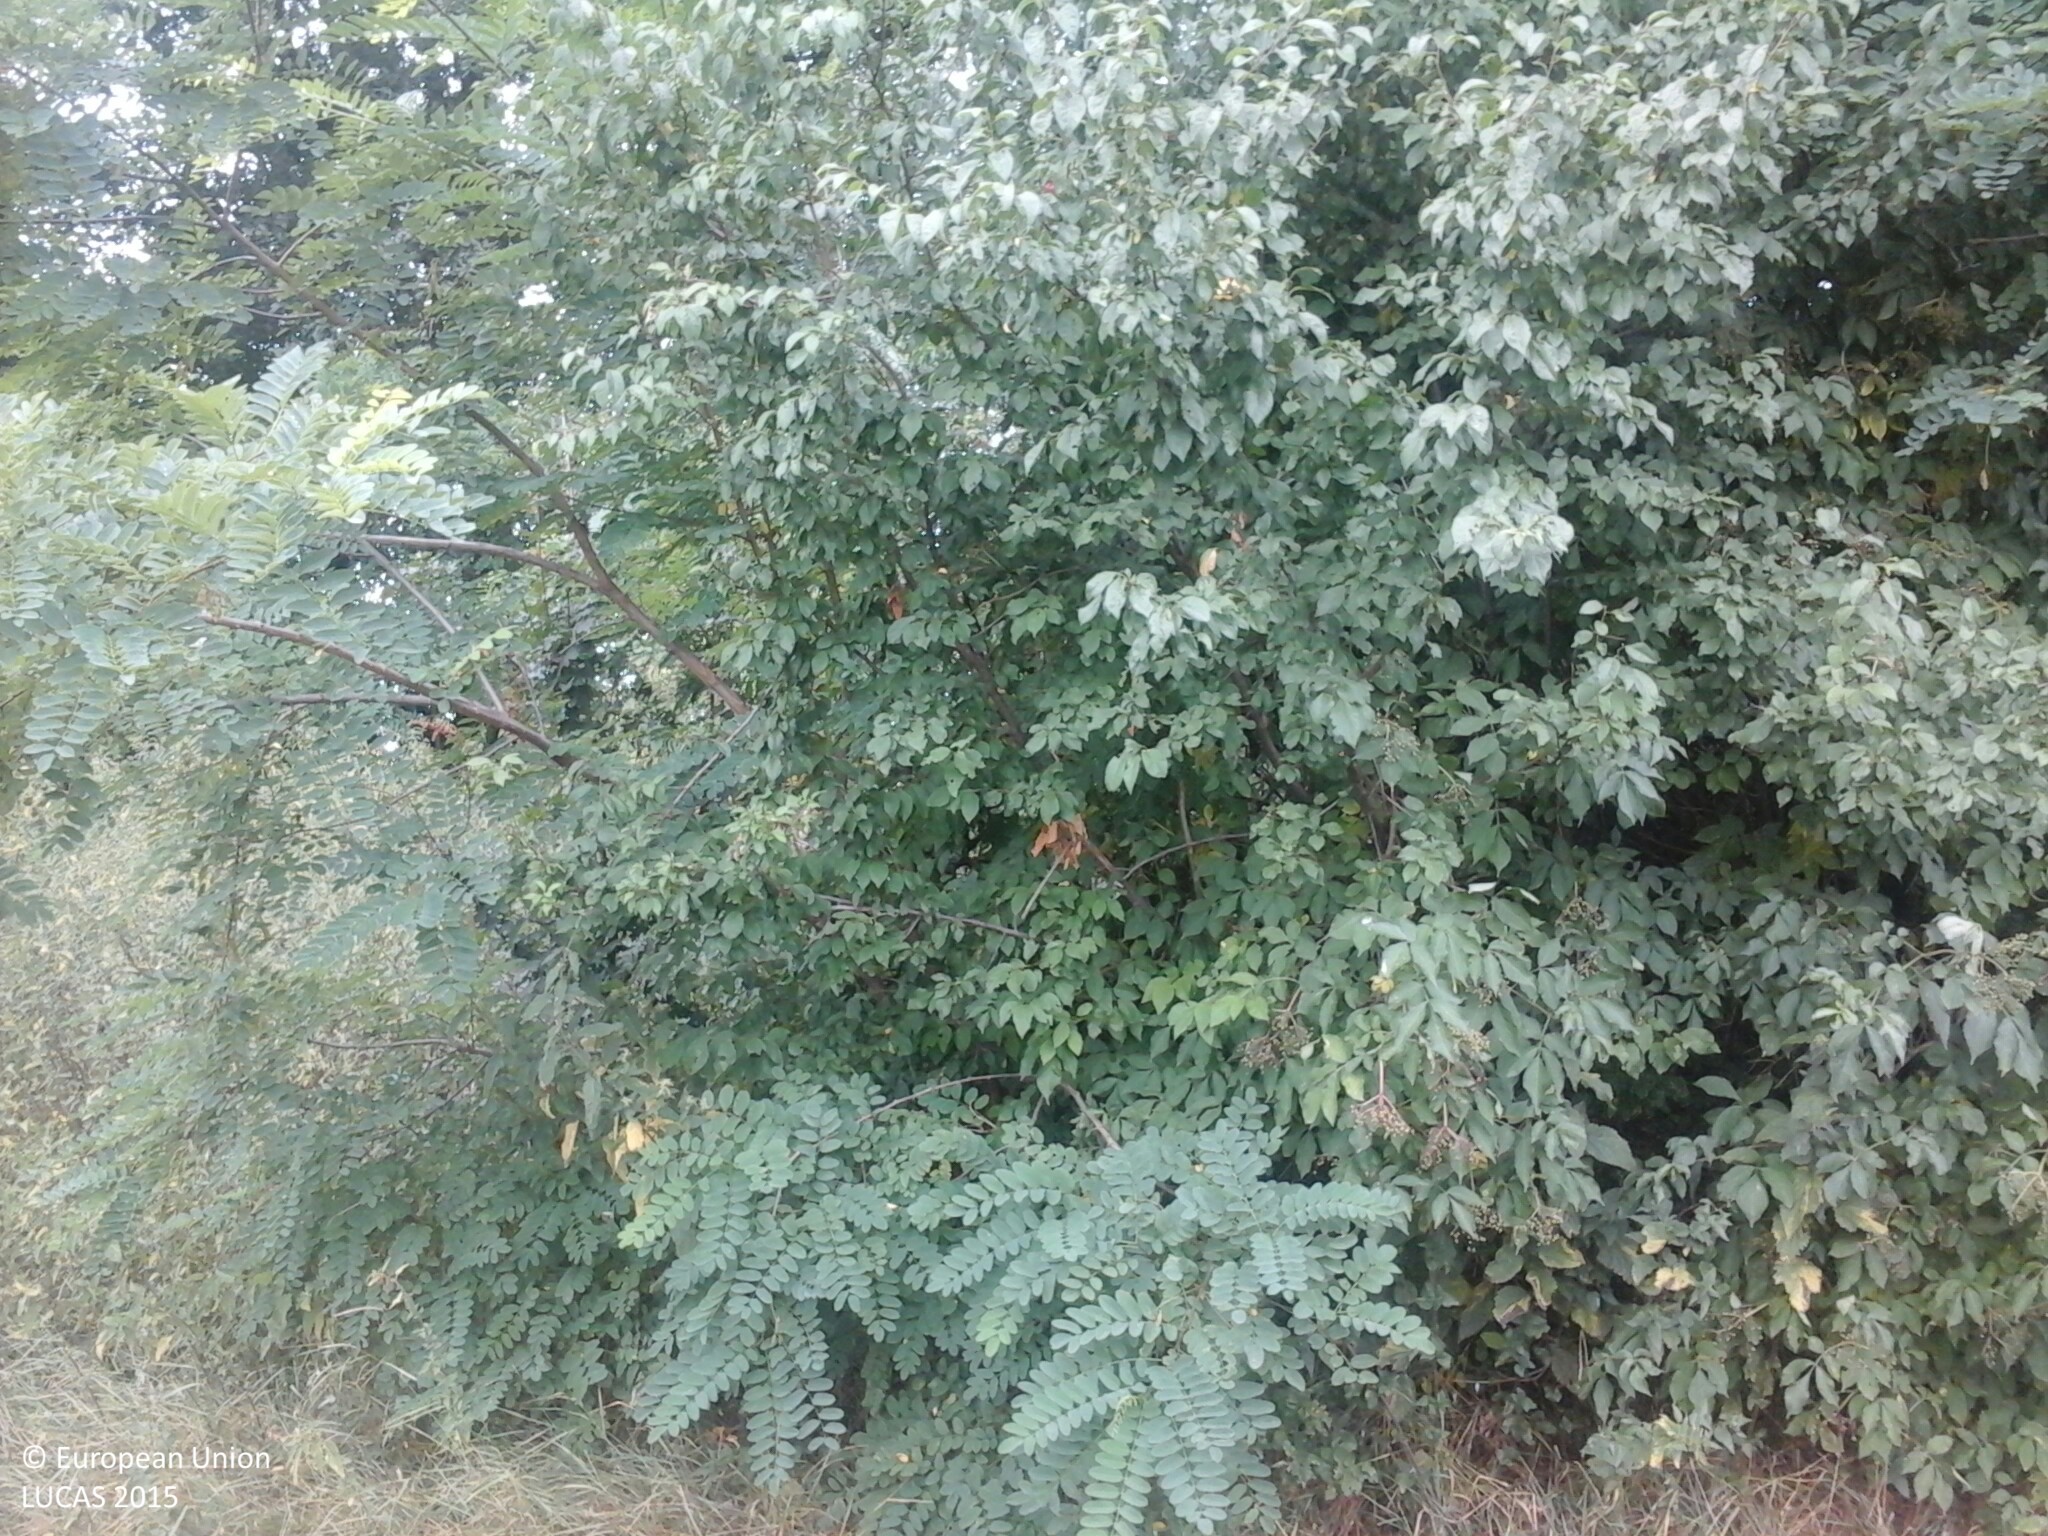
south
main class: Cropland
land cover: Cherry fruit
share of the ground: 50 - 75 %
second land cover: Grassland without tree/shrub cover
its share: 50 - 75 %
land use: Agriculture (excluding fallow land and kitchen gardens)
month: July
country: HU
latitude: 47.0522
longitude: 17.9204
